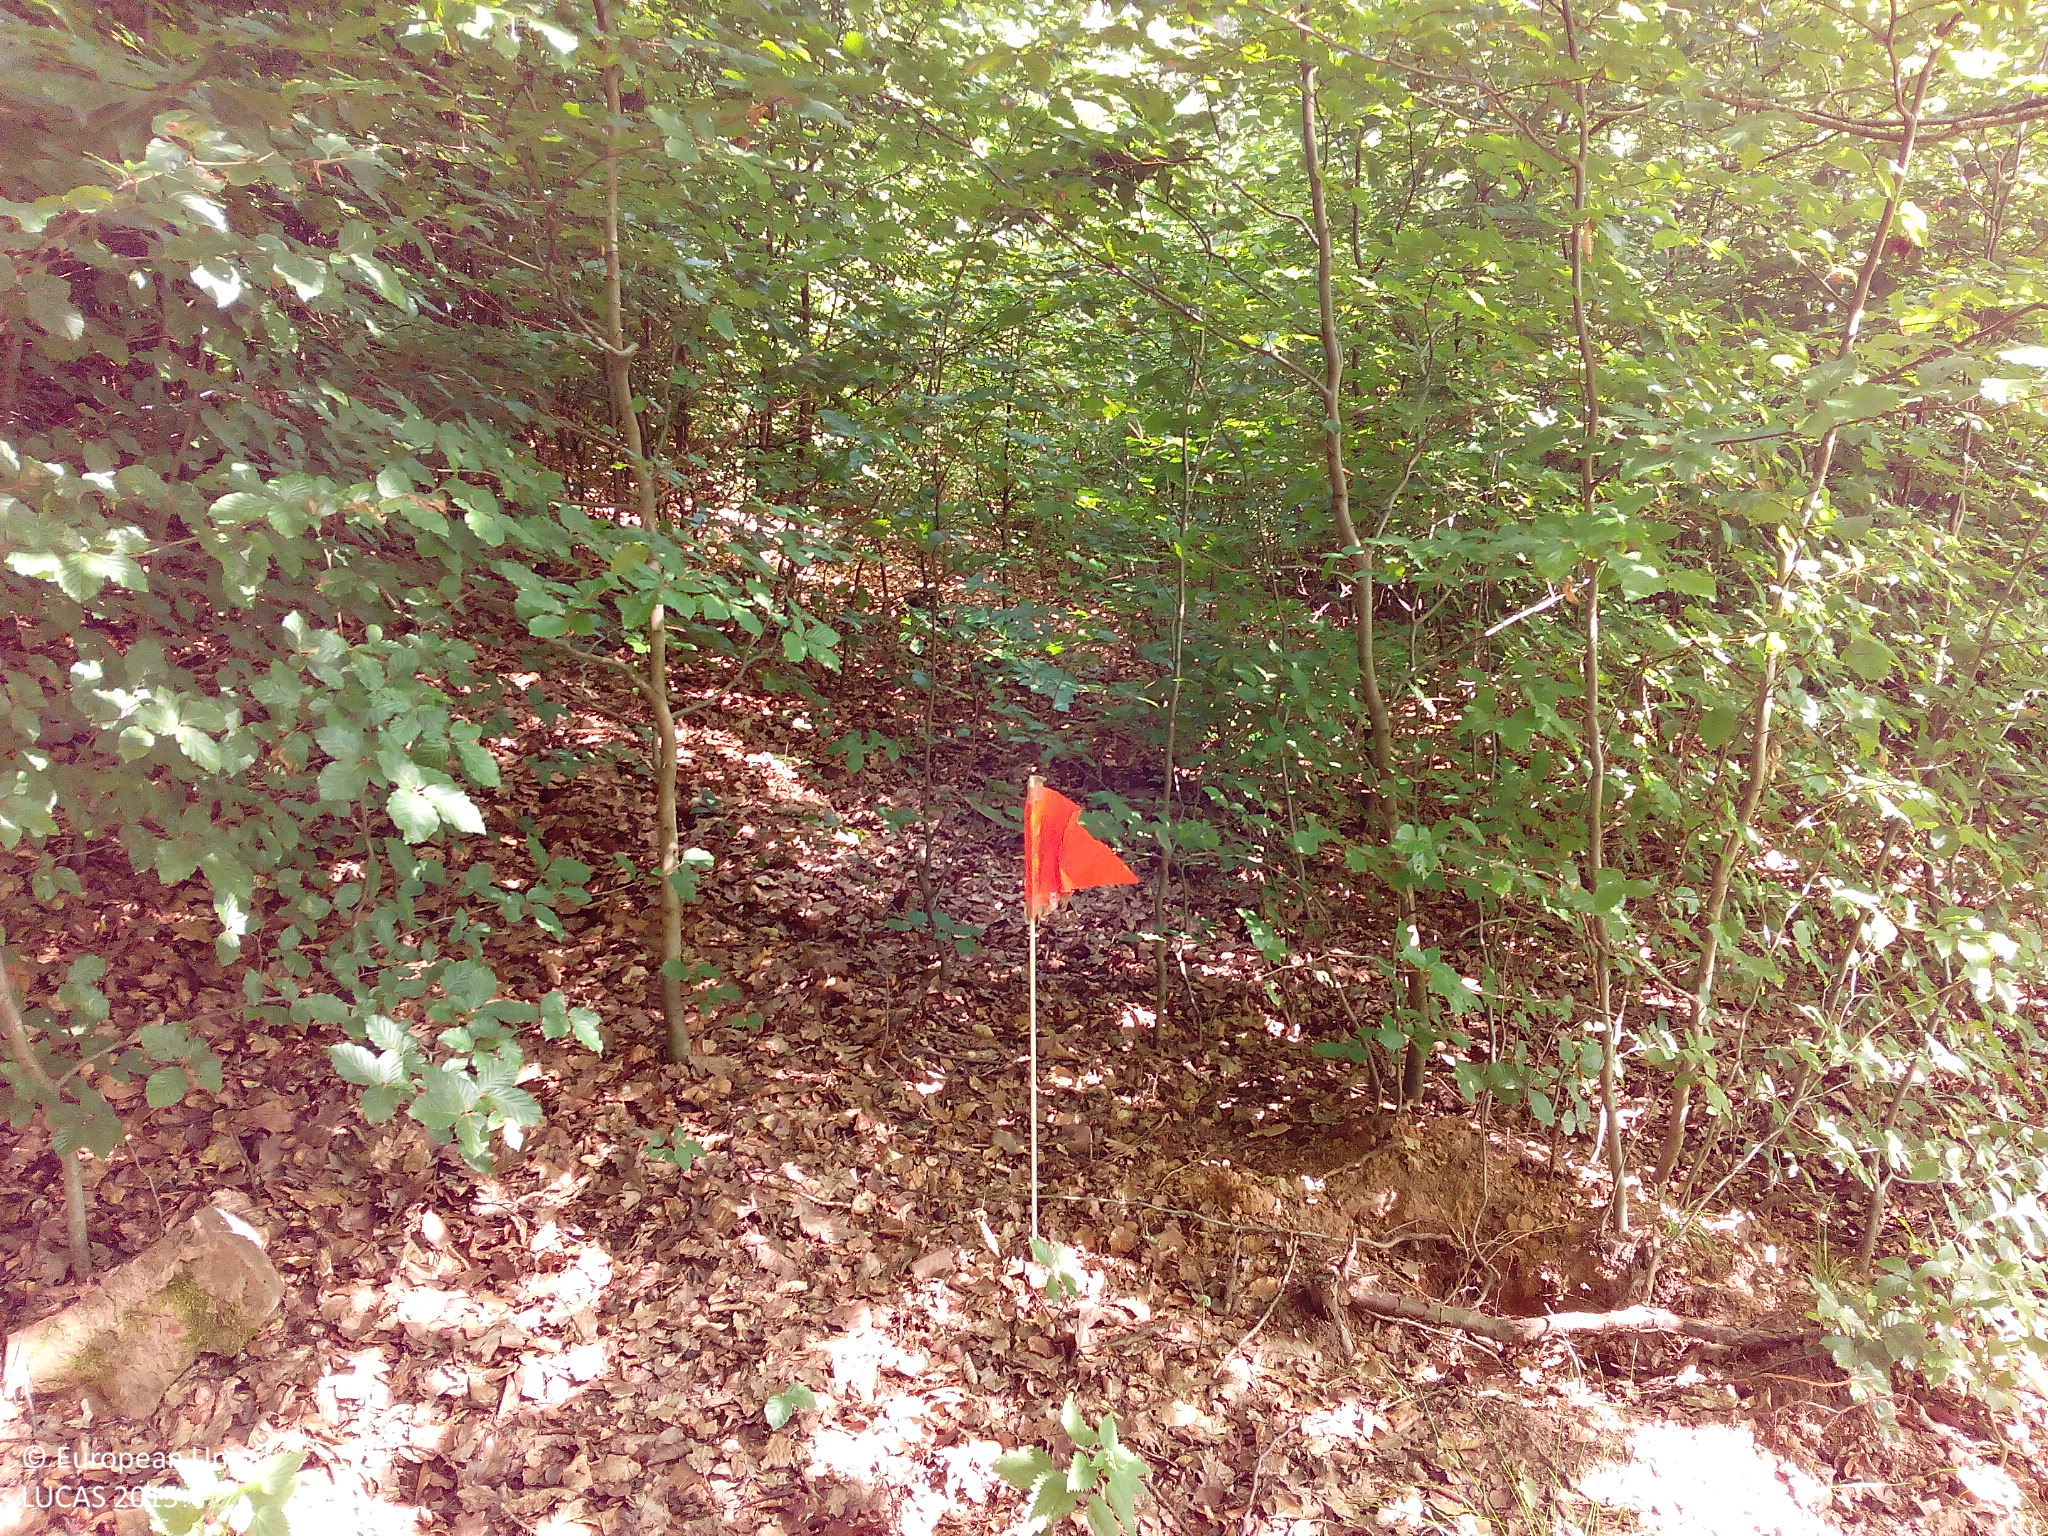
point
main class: Woodland
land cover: Broadleaved woodland
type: beech forest
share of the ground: > 75 %
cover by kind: broadleaved forest trees 80 %, herbaceous plants 15 %, unconsolidated bare surface 5 %
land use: Forestry
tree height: > 5 m
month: July
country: DE
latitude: 50.9033
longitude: 9.8436
